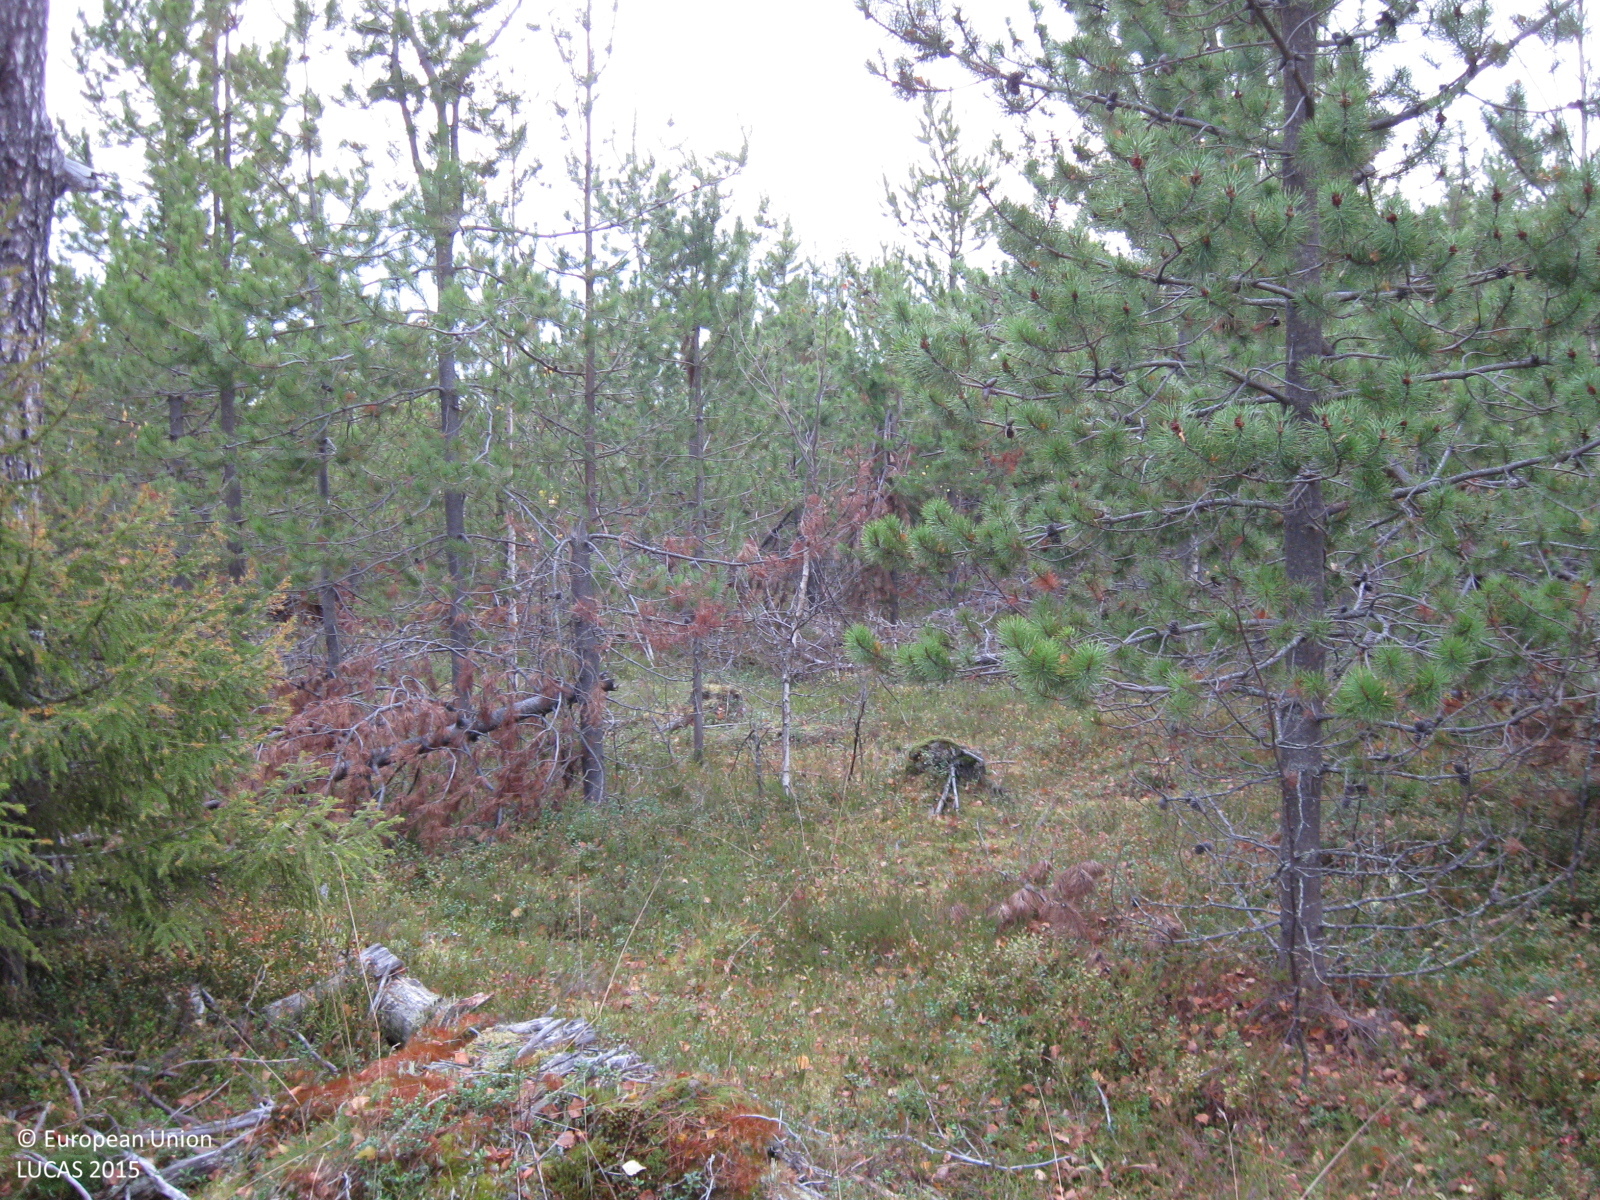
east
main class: Woodland
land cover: Pine dominated coniferous woodland
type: exotic forest
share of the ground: > 75 %
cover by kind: coniferous forest trees 80 %, broadleaved forest trees 5 %, herbaceous plants 5 %, lichens and mosses 5 %, unconsolidated bare surface 5 %
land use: Forestry
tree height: > 5 m
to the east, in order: Pine dominated coniferous woodland; Pine dominated mixed woodland; Spruce dominated coniferous woodland
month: October
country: SE
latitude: 66.1070
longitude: 22.2094
